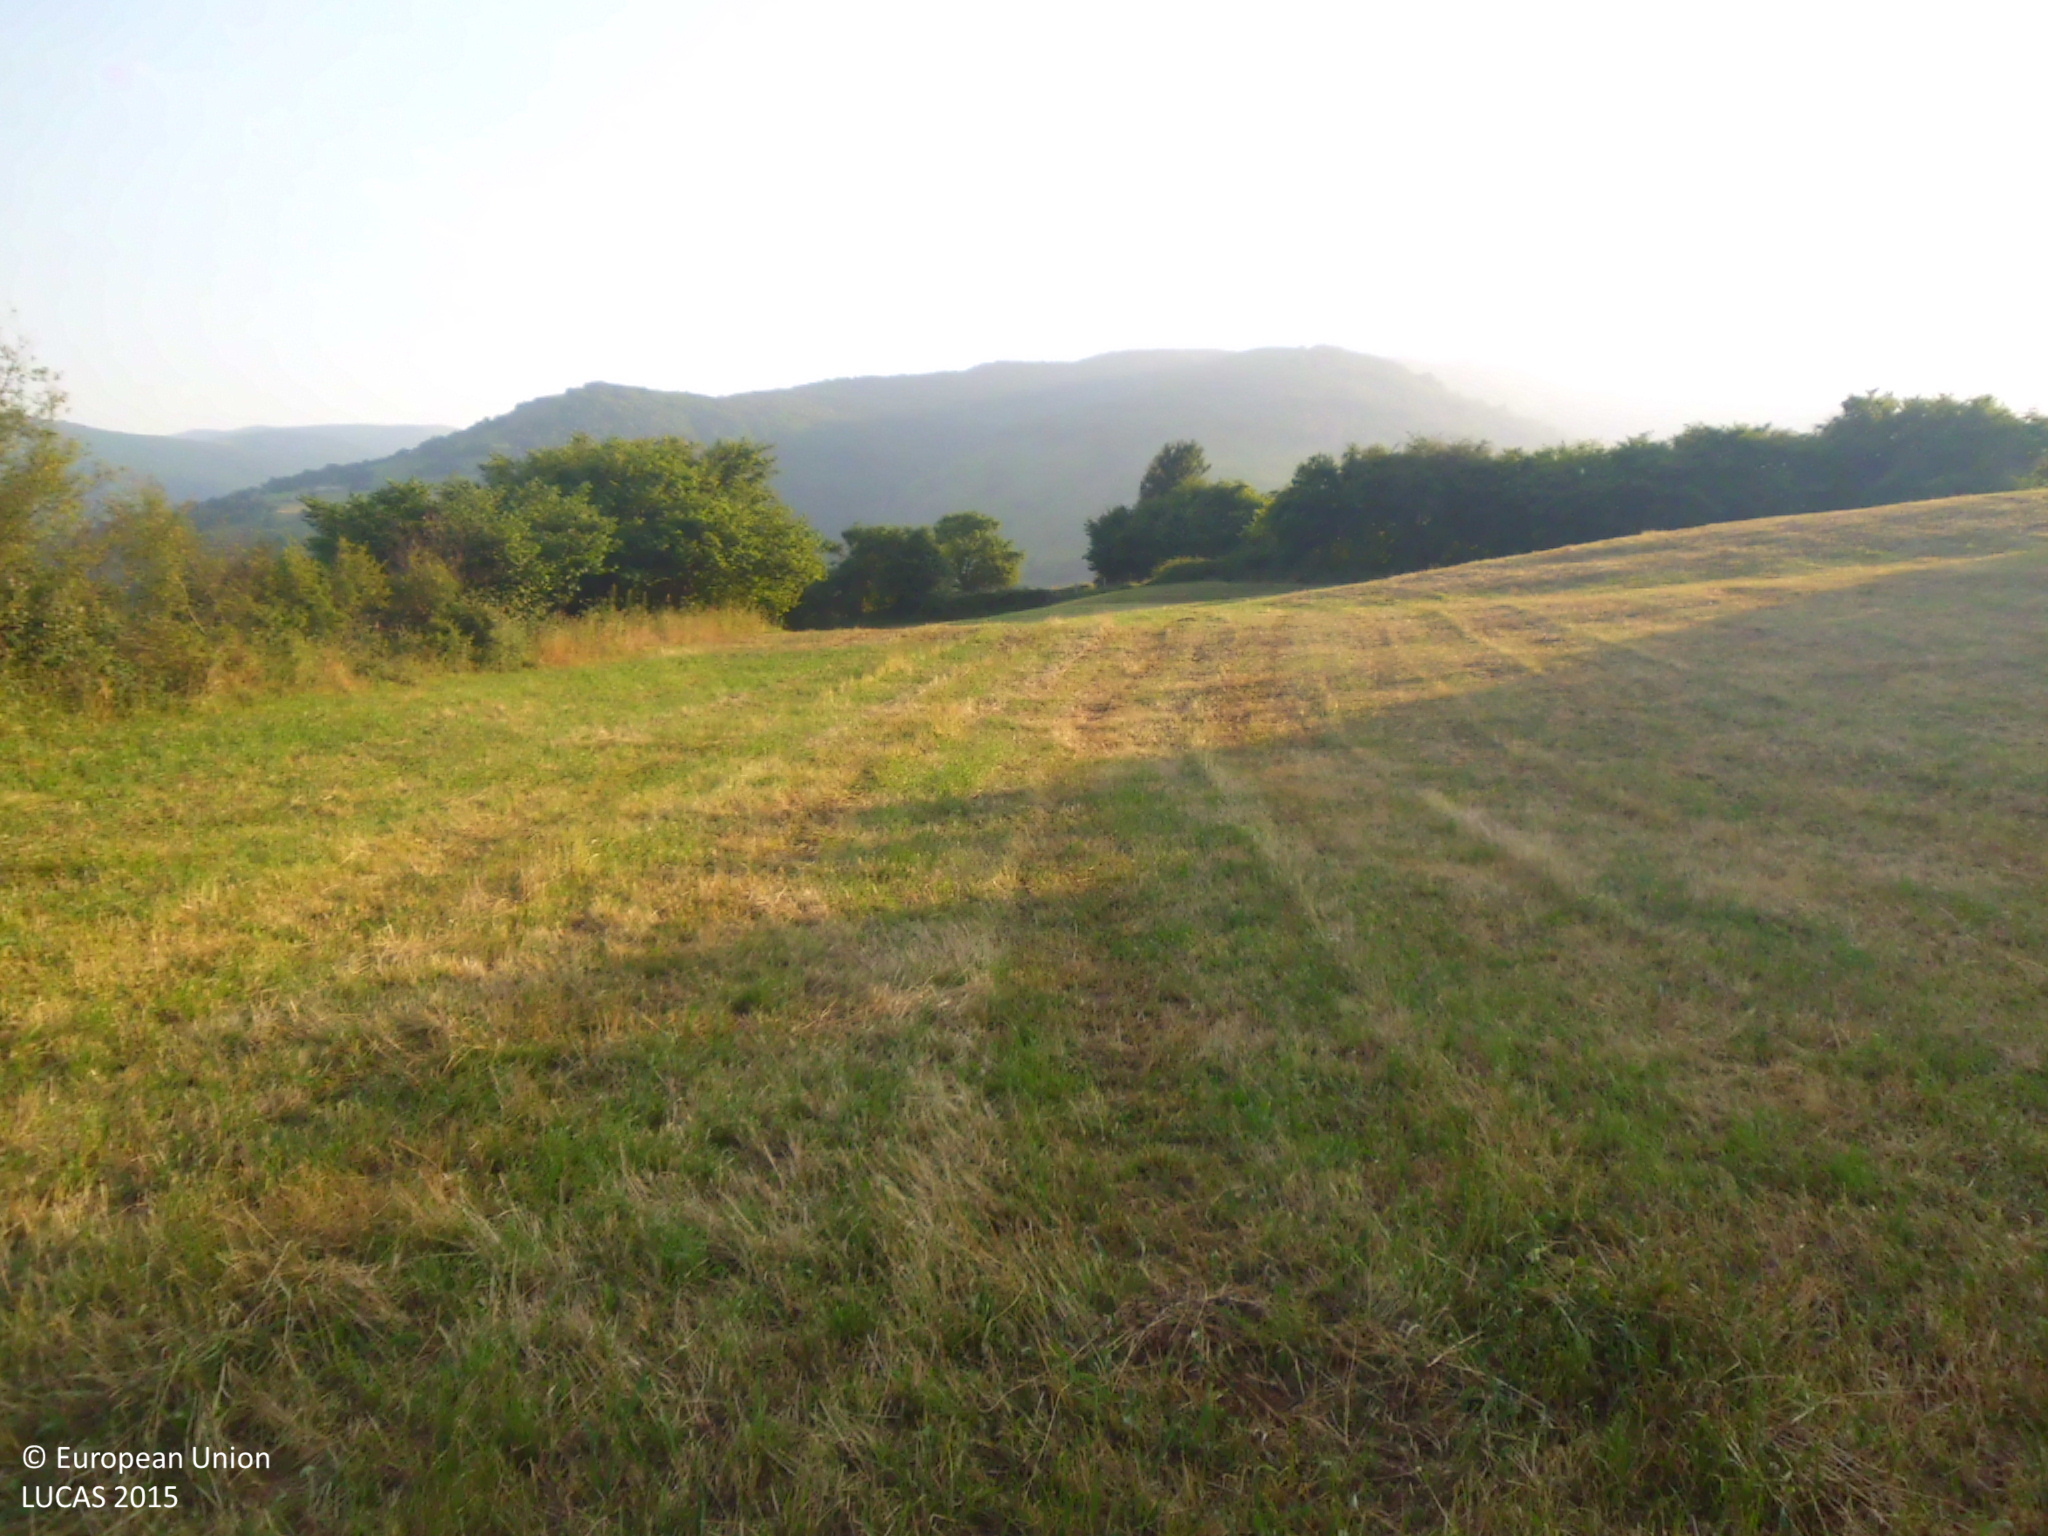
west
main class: Grassland
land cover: Grassland without tree/shrub cover
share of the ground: > 75 %
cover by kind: herbaceous plants 95 %, shrubs 5 %
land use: Agriculture (excluding fallow land and kitchen gardens)
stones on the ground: < 10 %
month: June
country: ES
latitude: 43.1294
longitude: -4.0762
